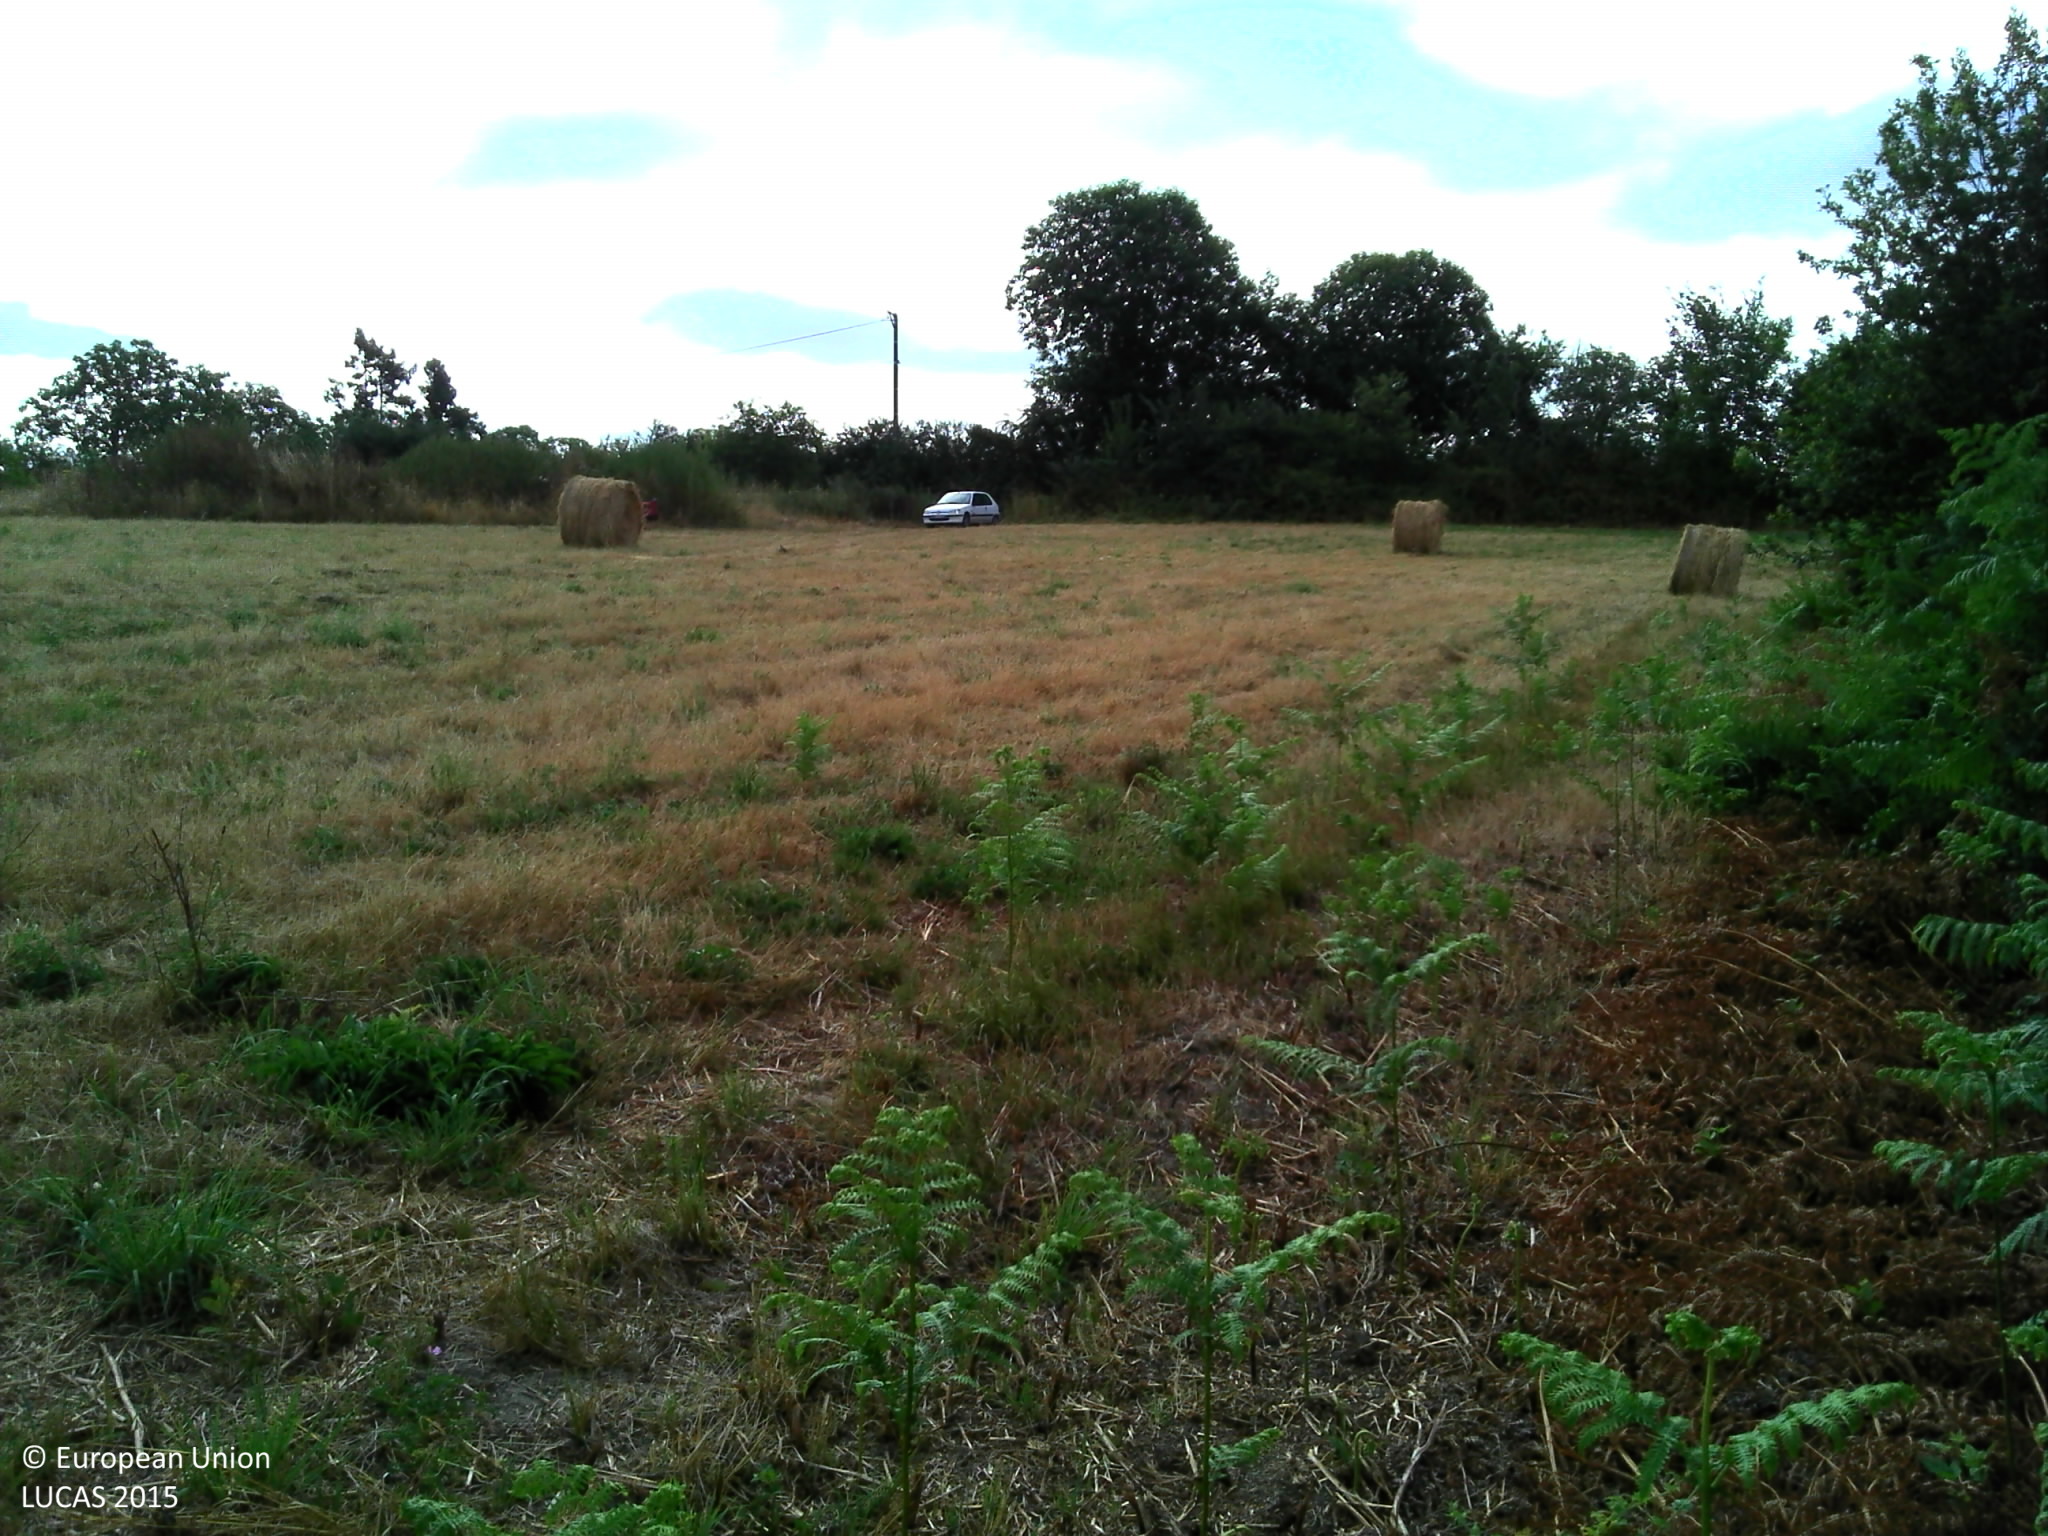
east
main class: Grassland
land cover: Grassland without tree/shrub cover
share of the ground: > 75 %
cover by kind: herbaceous plants 95 %
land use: Agriculture (excluding fallow land and kitchen gardens)
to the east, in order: Grassland without tree/shrub cover; Spontaneously vegetated surfaces; Fences; Abandoned hedges; Grass margins; Paved roads, cycling and walking lanes; Grass margins; Ditches and canals; Grass margins; Electric lines; Fences; Abandoned hedges; Sunflower; Maize; Other bare soil; Grassland without tree/shrub cover; Broadleaved woodland; Grassland without tree/shrub cover
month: July
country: FR
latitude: 45.8455
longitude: 1.0141
